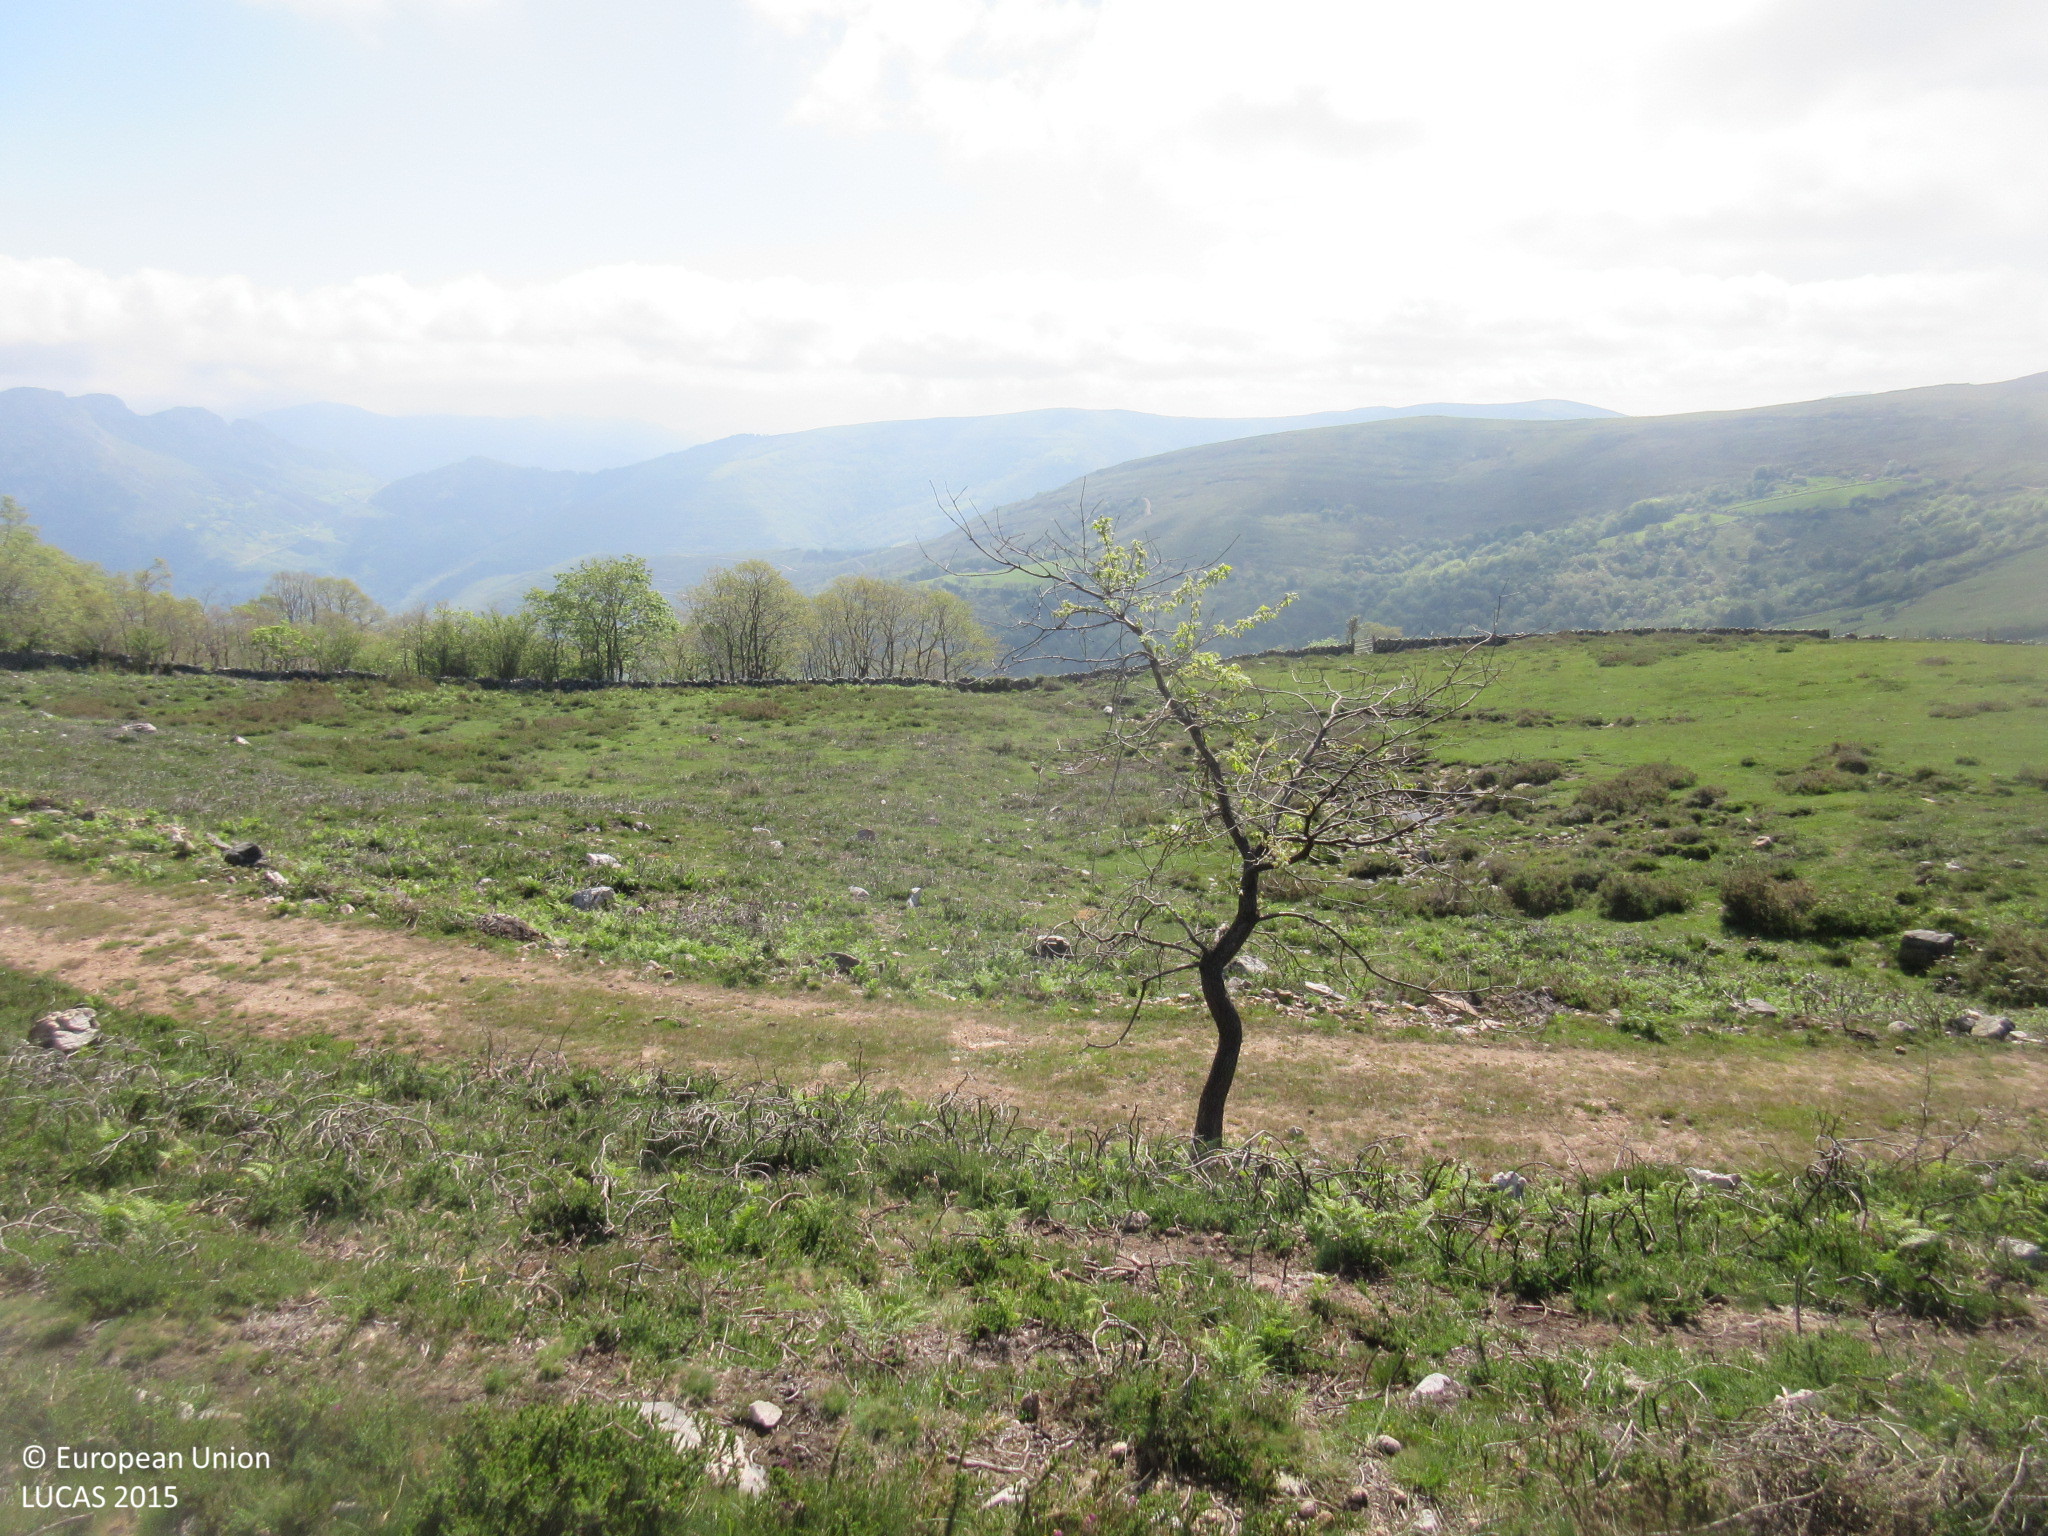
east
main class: Shrubland
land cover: Shrubland without tree cover
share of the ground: > 75 %
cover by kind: shrubs 85 %, herbaceous plants 15 %
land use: Agriculture (excluding fallow land and kitchen gardens)
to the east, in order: Shrubland without tree cover; Tracks; Shrubland without tree cover; Dry stone walls; Grassland without tree/shrub cover
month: May
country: ES
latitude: 43.2304
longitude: -4.5269
